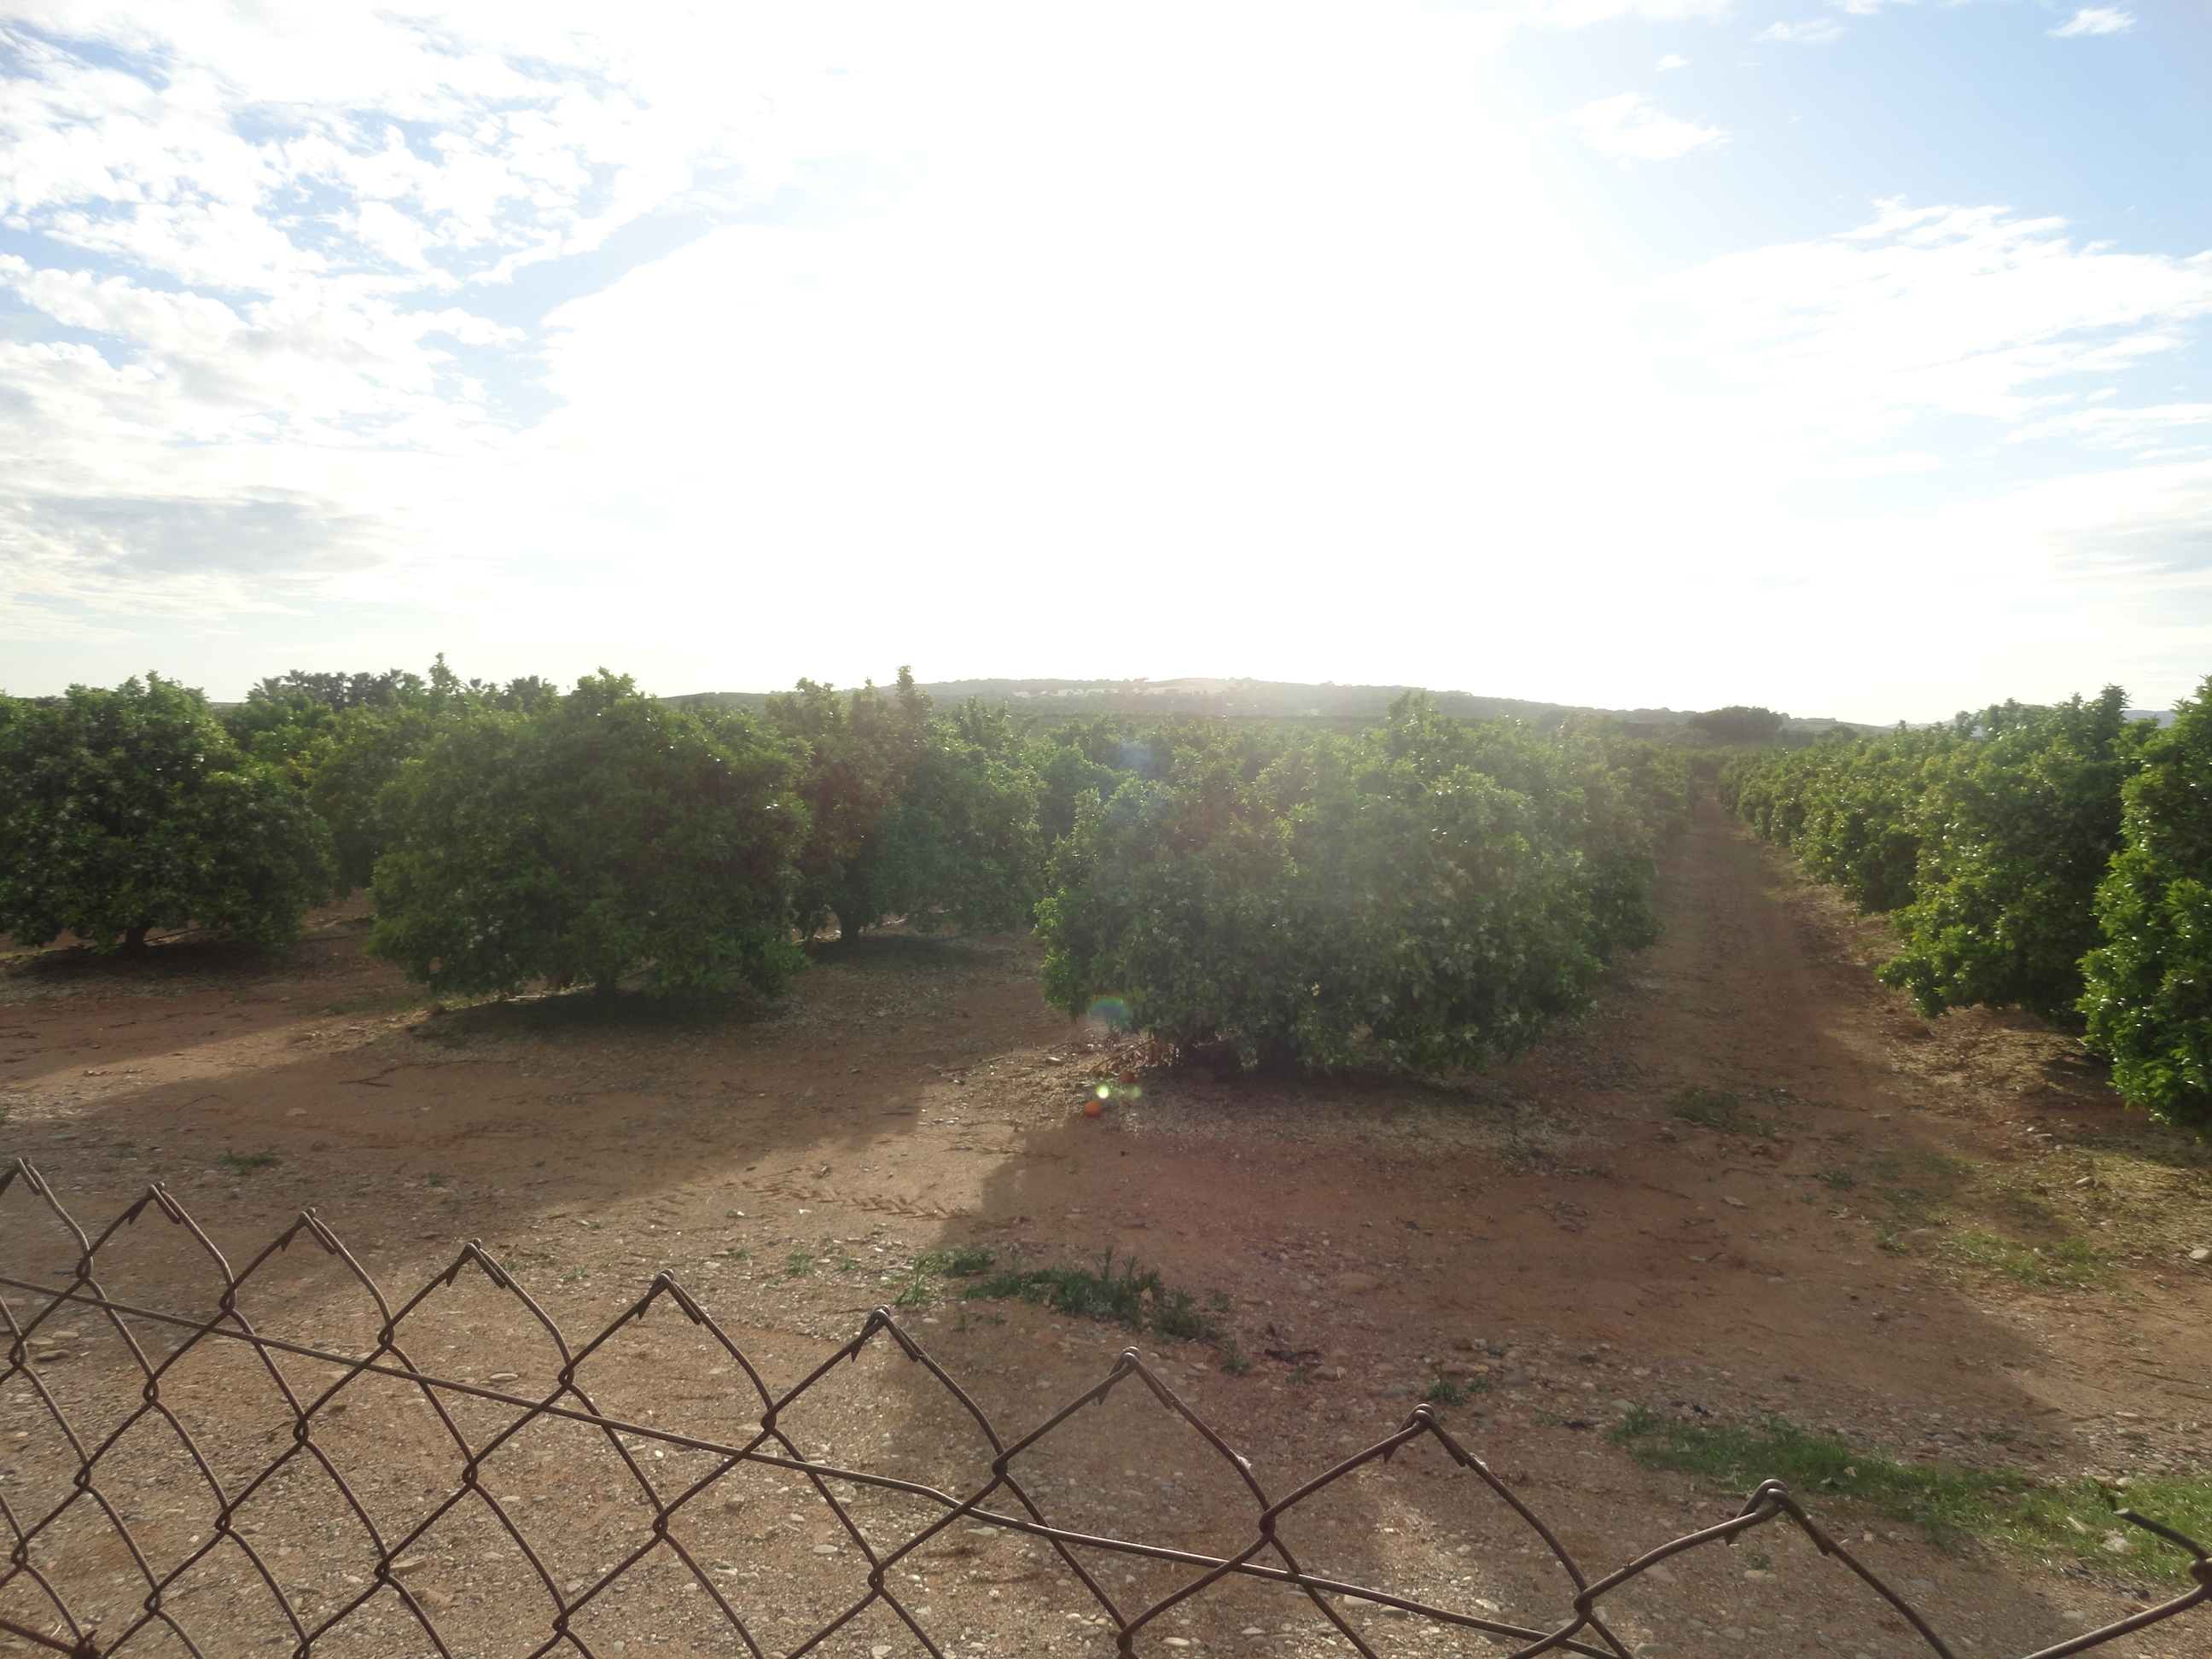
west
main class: Cropland
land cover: Oranges
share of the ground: 50 - 75 %
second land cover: Other bare soil
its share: > 75 %
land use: Agriculture (excluding fallow land and kitchen gardens)
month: April
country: ES
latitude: 37.7453
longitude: -5.2372
